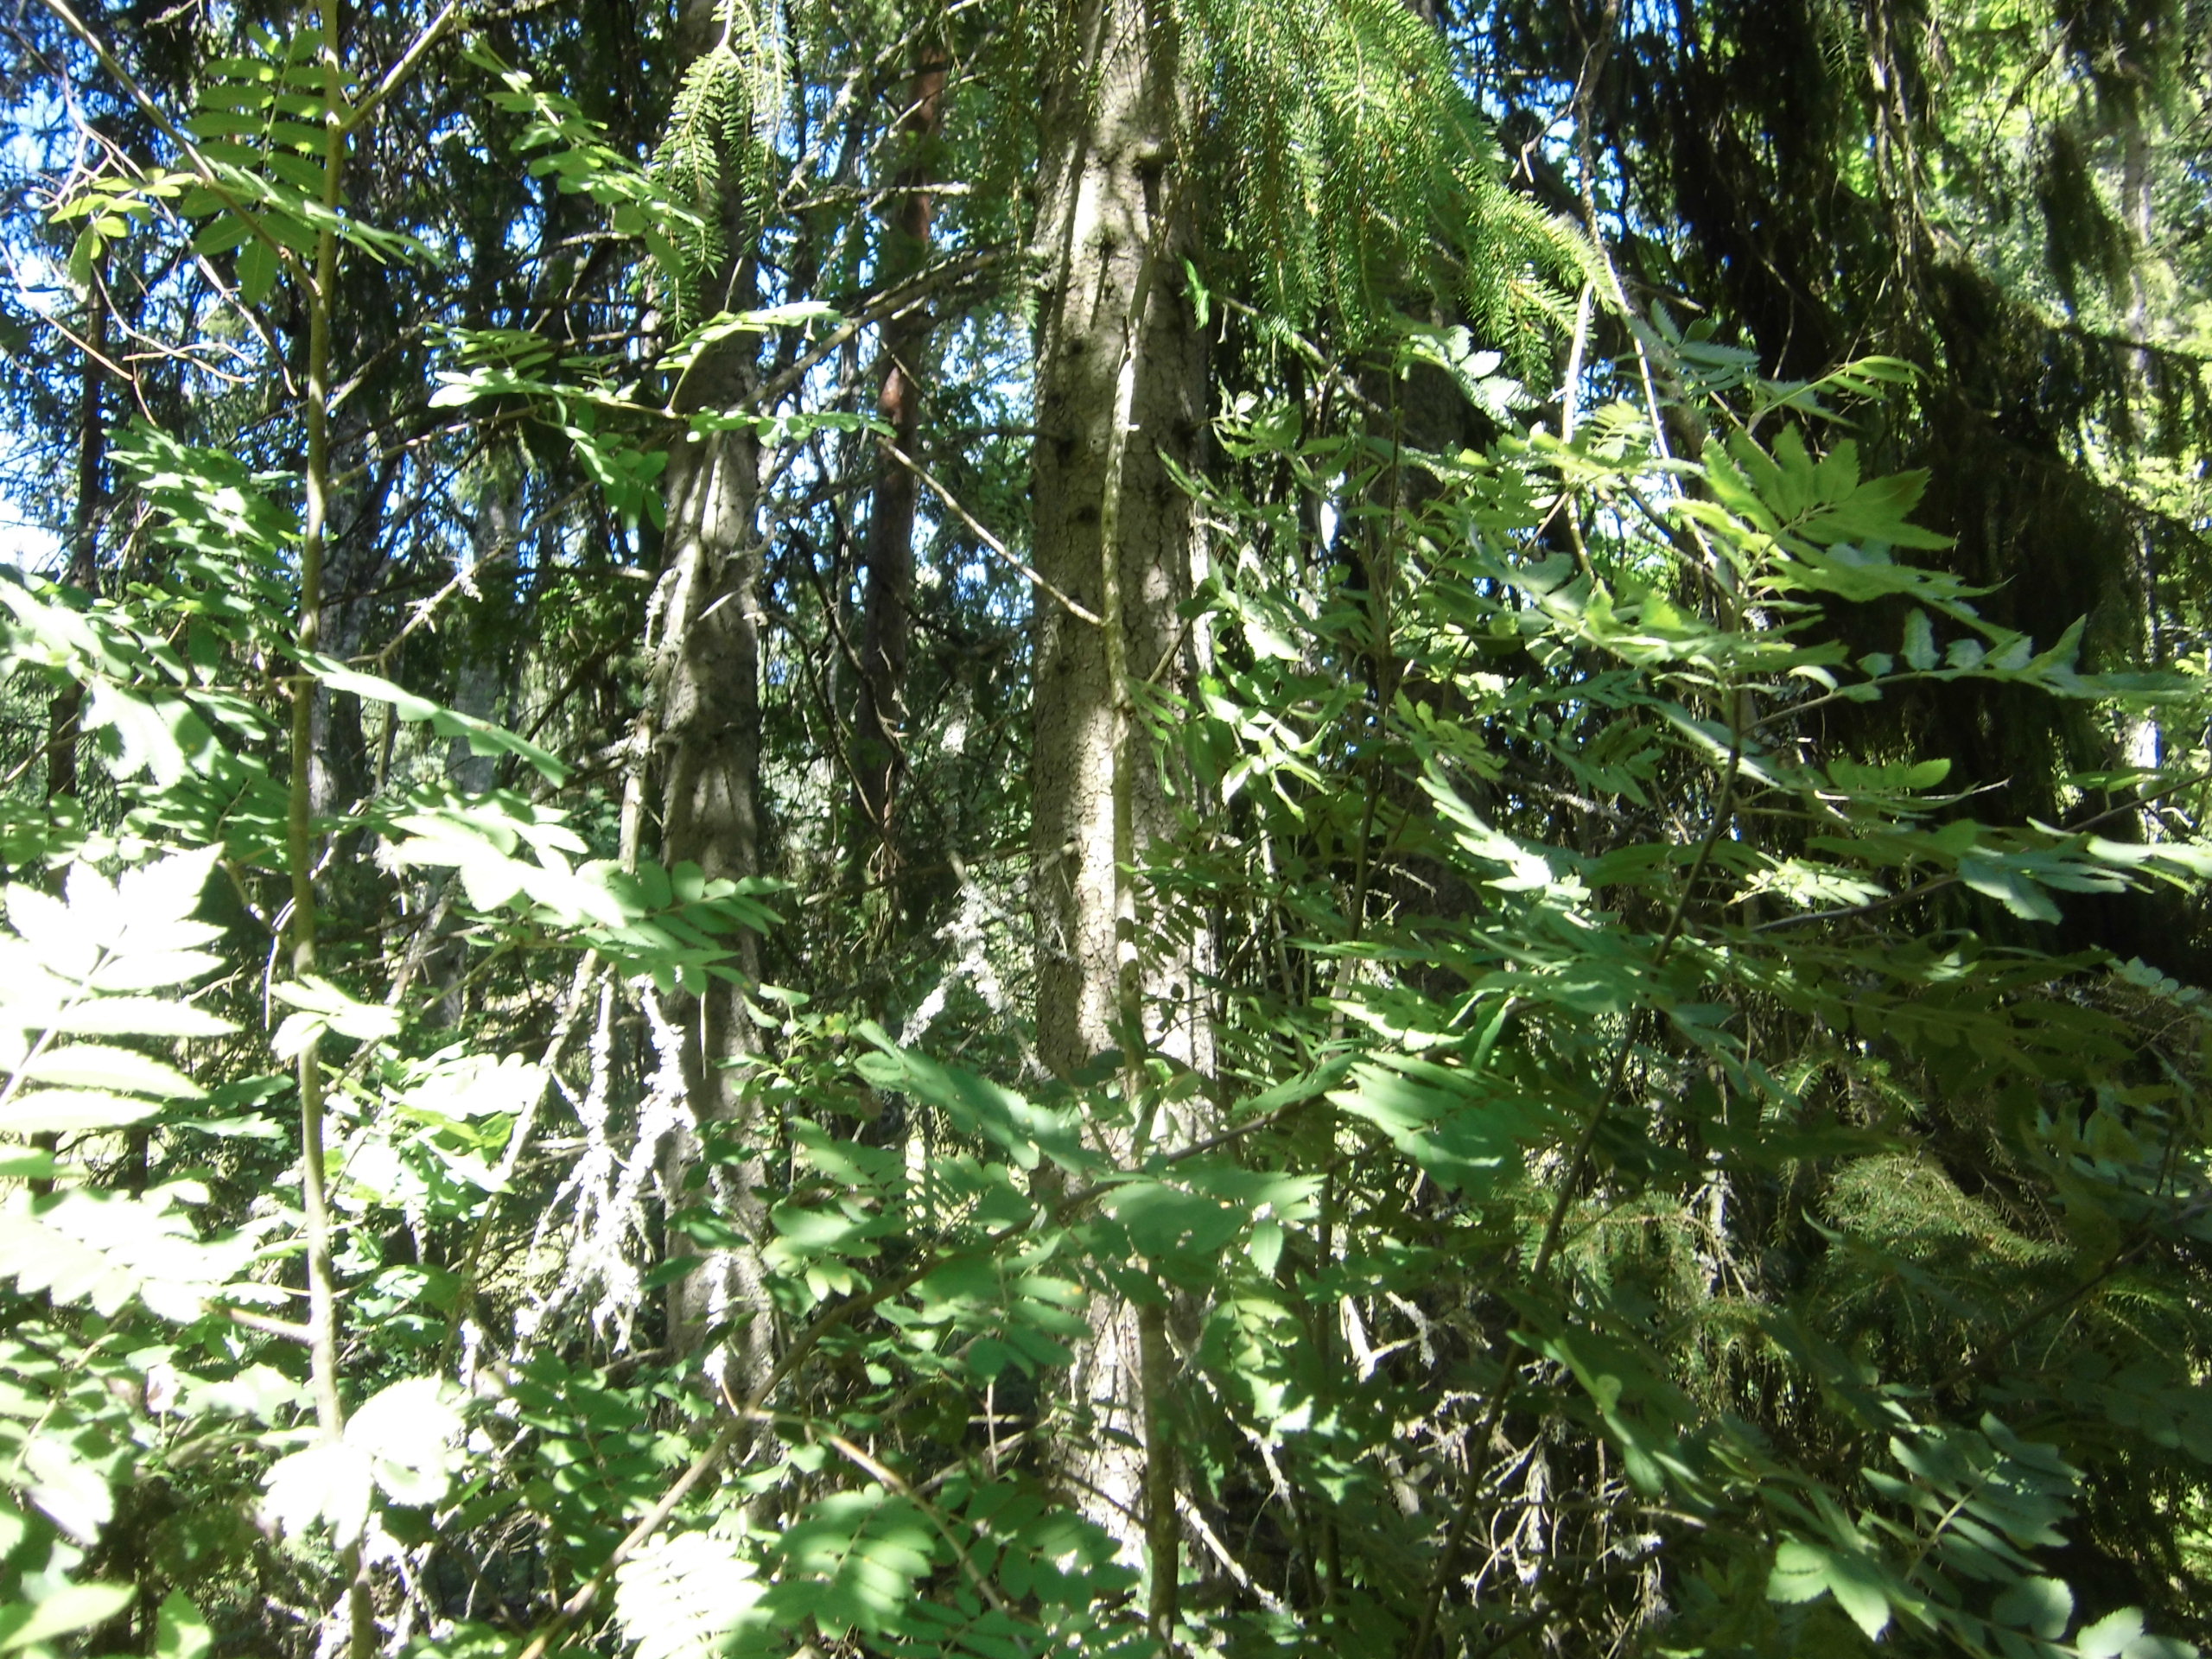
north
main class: Woodland
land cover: Spruce dominated mixed woodland
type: boreal forest
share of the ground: > 75 %
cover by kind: broadleaved forest trees 45 %, coniferous forest trees 30 %, herbaceous plants 15 %, shrubs 5 %, lichens and mosses 5 %
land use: Forestry
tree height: > 5 m
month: July
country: SE
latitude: 57.3413
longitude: 15.2638
